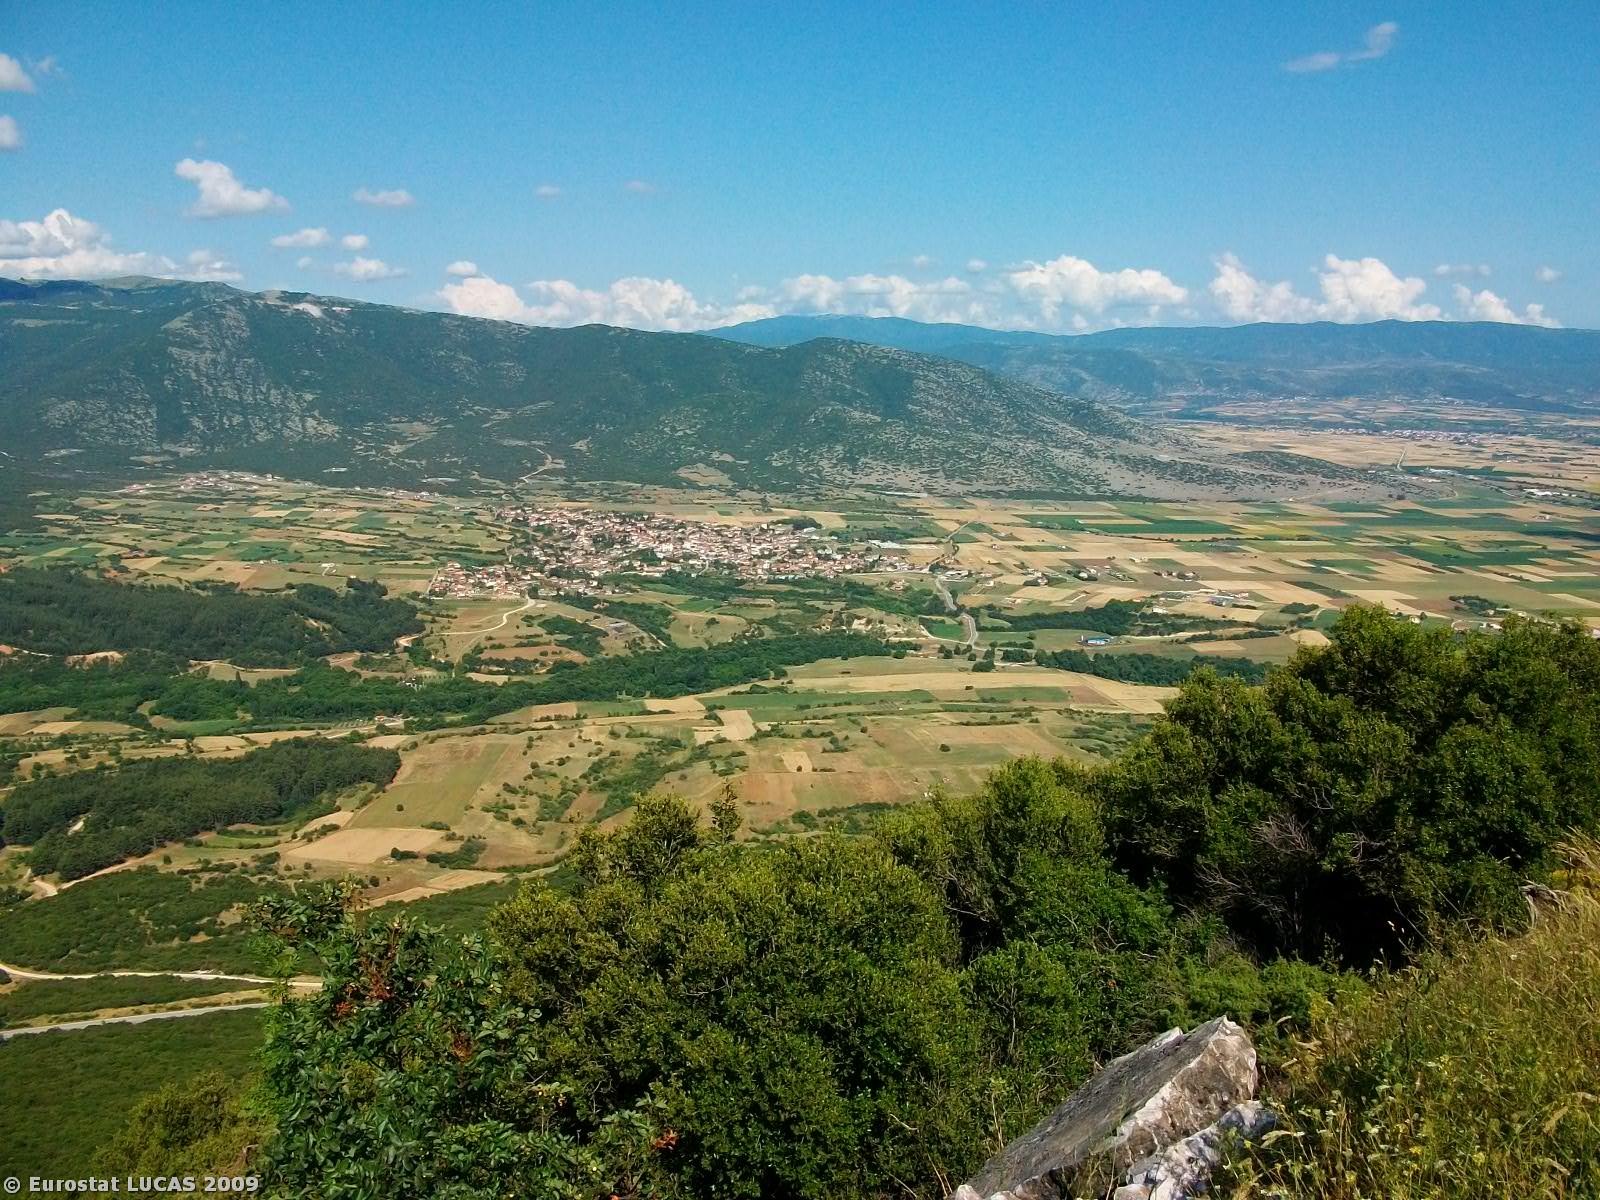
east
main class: Shrubland
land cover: Shrubland with sparse tree cover
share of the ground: > 75 %
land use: Unused
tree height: < 5 m
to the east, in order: Shrubland with sparse tree cover; Shrubland without tree cover
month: June
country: GR
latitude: 41.1746
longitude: 24.1793
